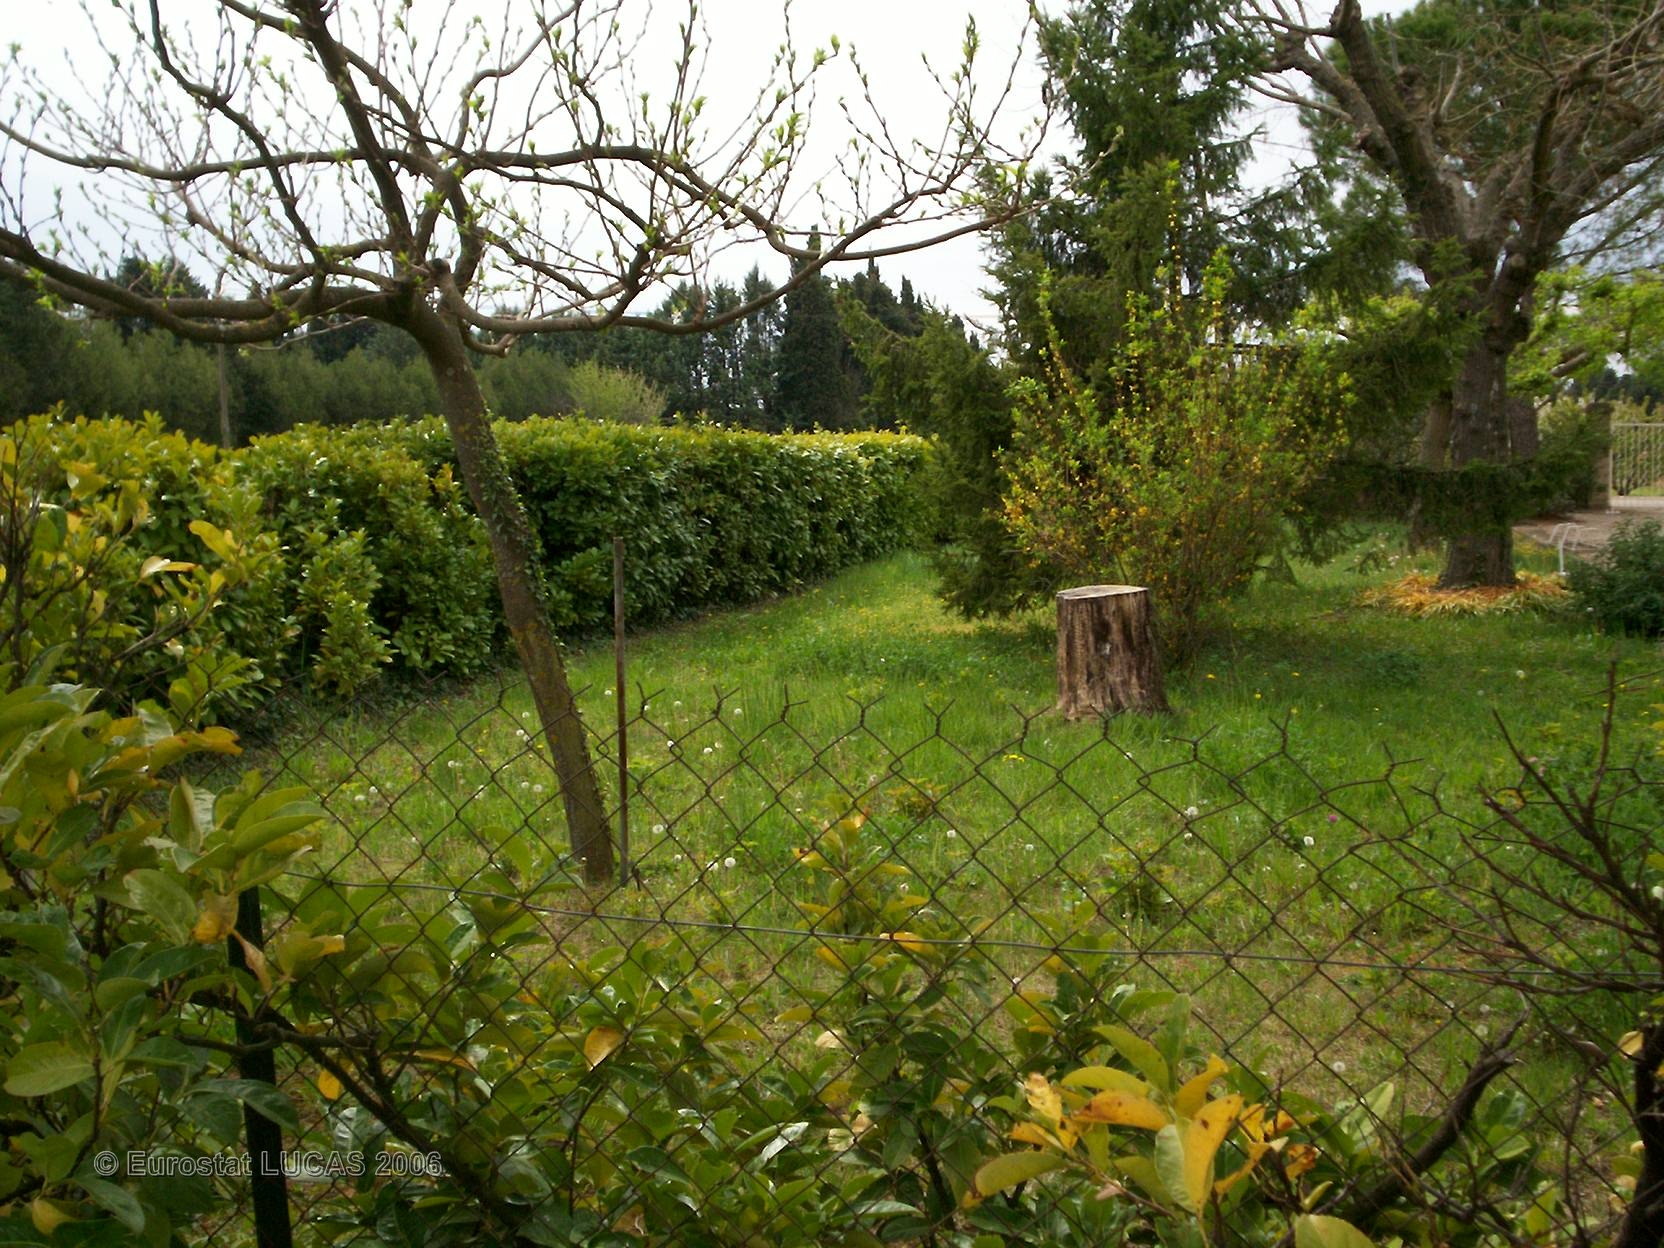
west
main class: Grassland
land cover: Grassland with sparse tree/shrub cover
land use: Residential
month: April
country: FR
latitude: 43.8144
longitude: 4.9988
